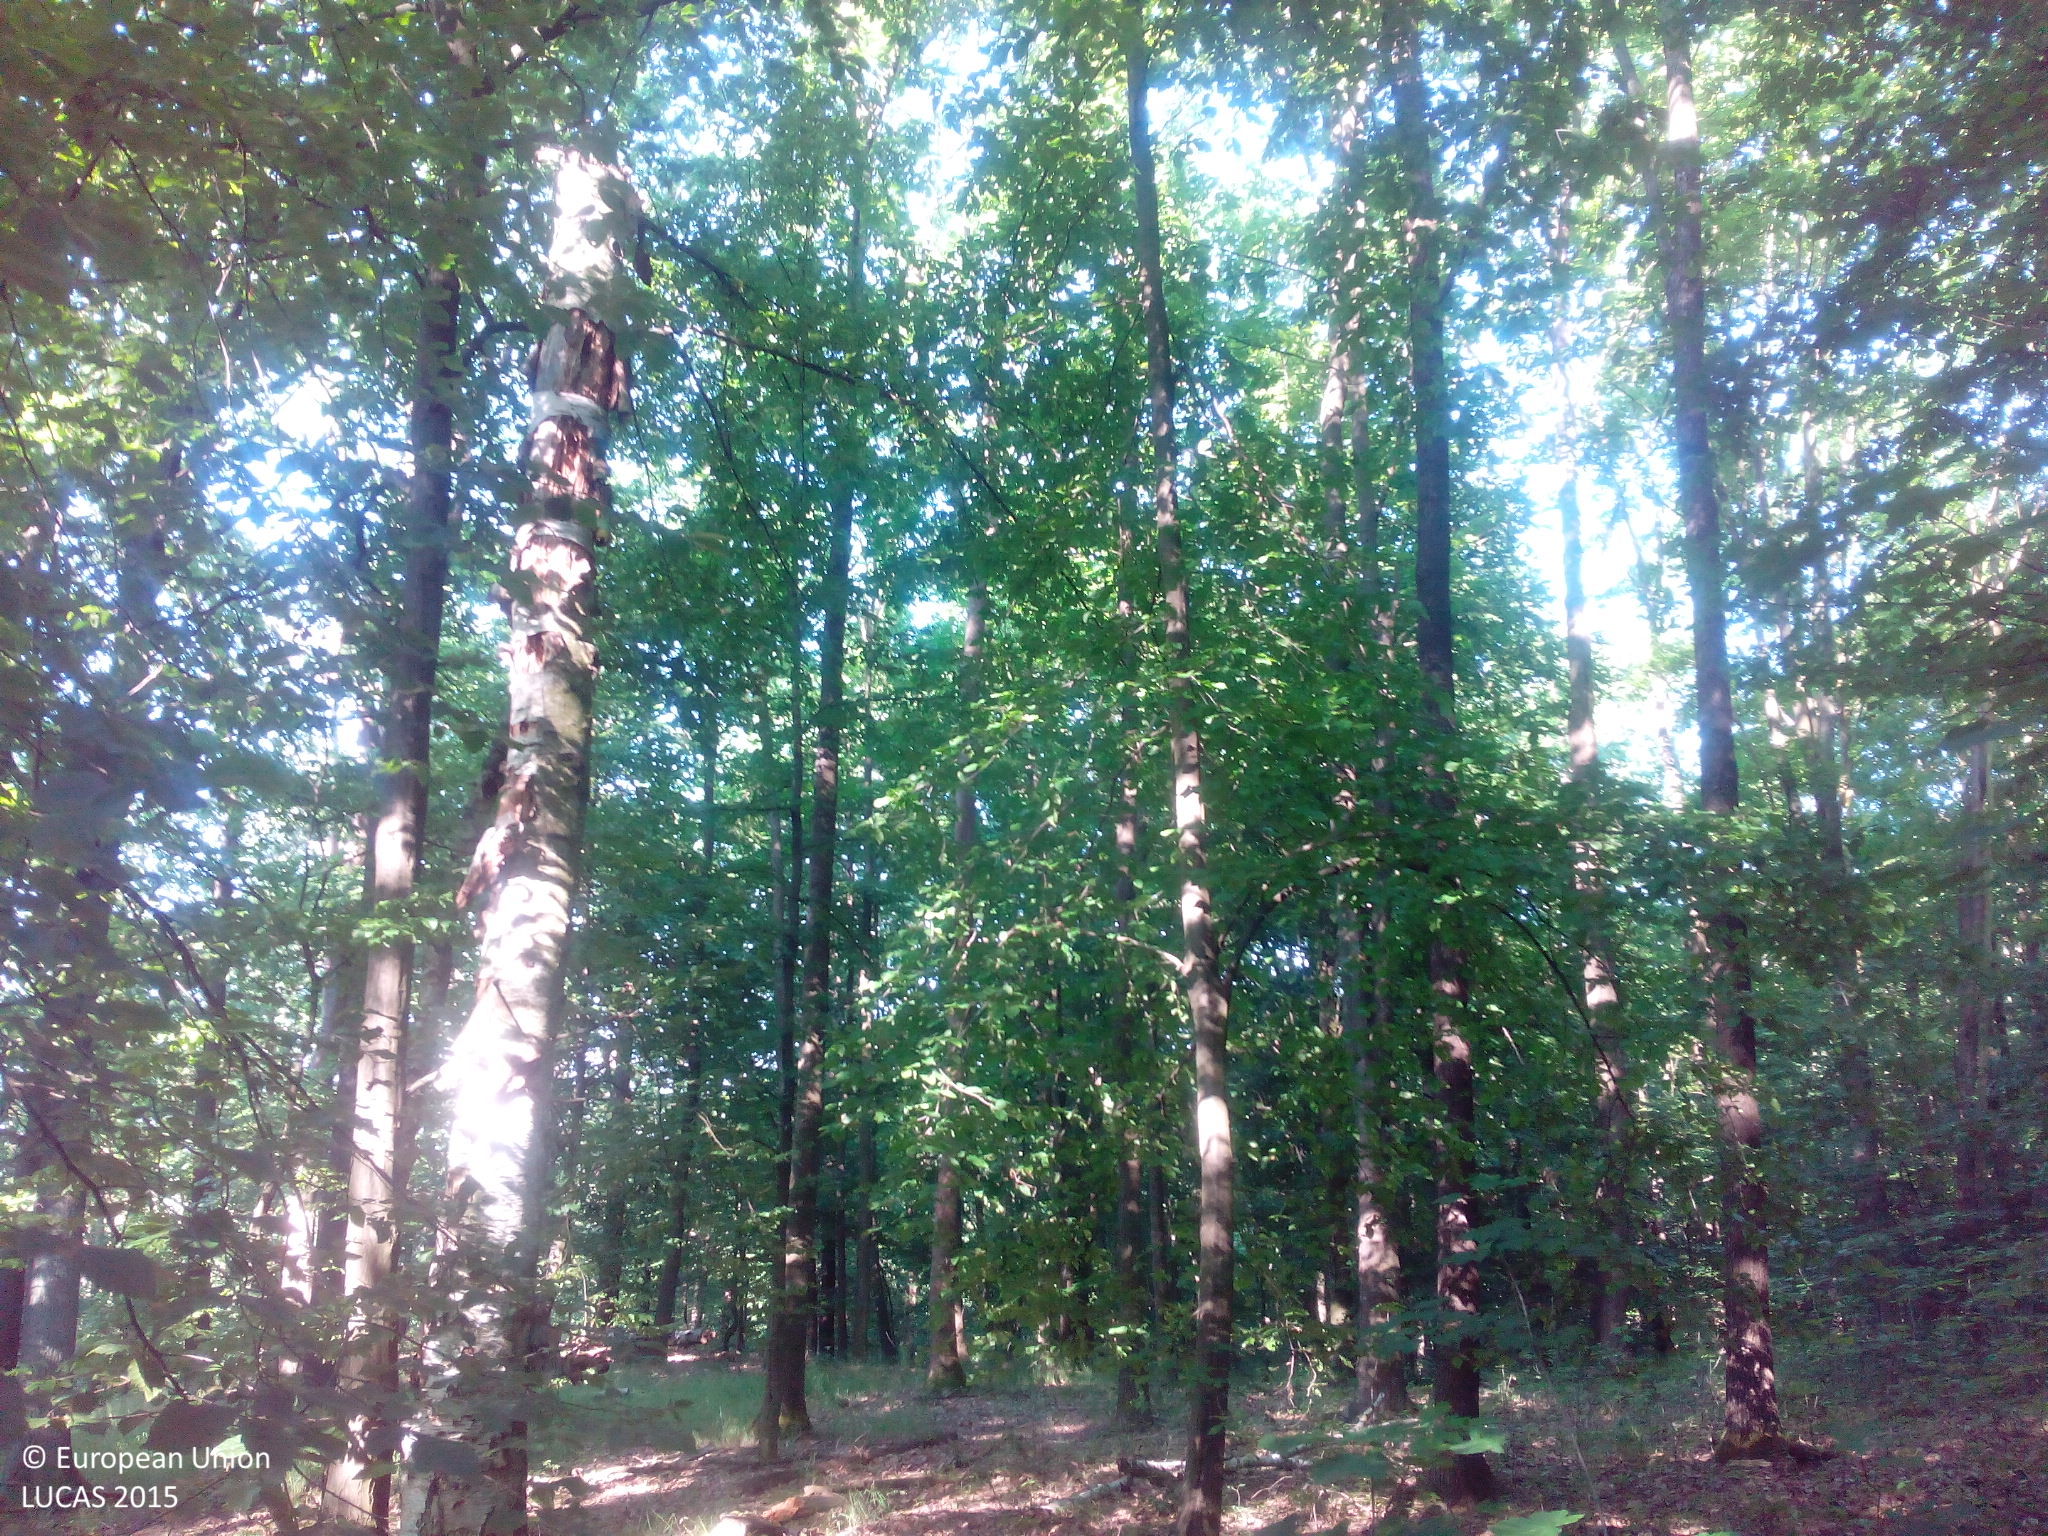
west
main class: Woodland
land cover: Broadleaved woodland
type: beech forest
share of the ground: > 75 %
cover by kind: broadleaved forest trees 100 %
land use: Forestry
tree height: > 5 m
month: June
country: DE
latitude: 50.9357
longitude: 13.0310
